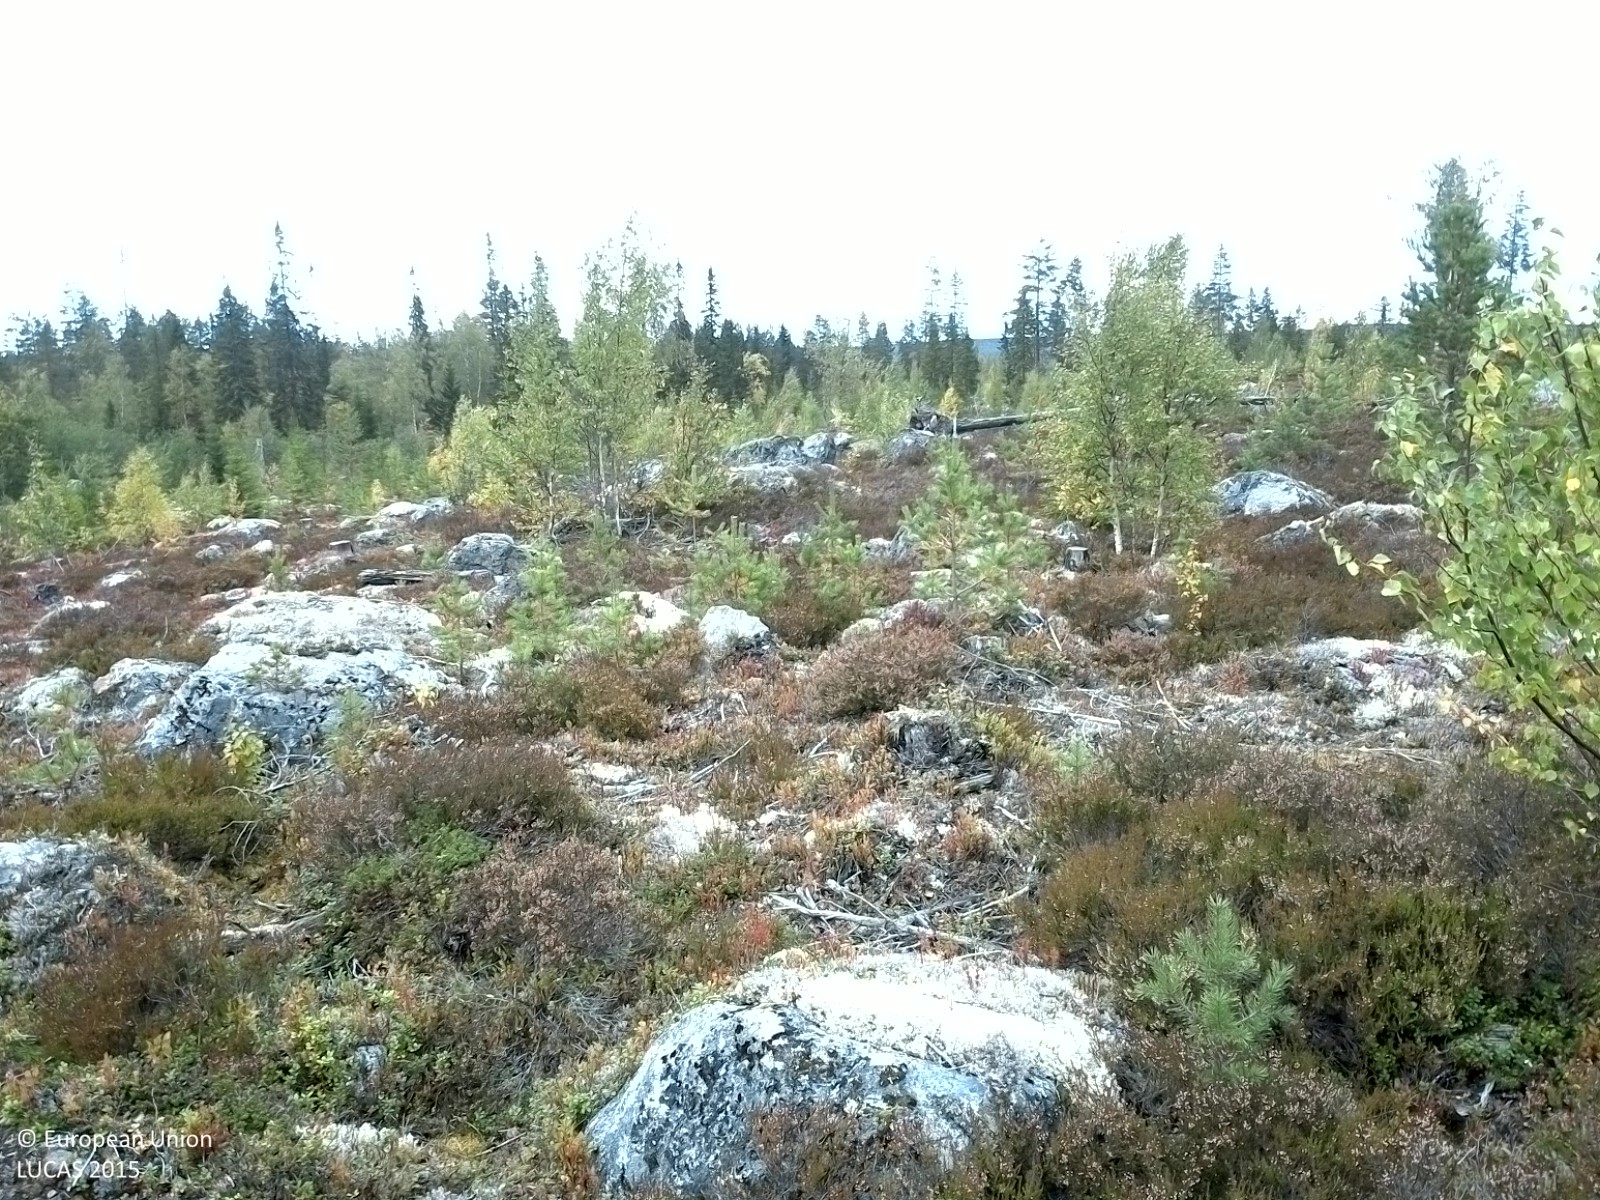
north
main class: Woodland
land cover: Other mixed woodland
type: boreal forest
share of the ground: 10 - 25 %
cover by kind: shrubs 60 %, consolidated bare surface 20 %, lichens and mosses 10 %, coniferous forest trees 5 %, broadleaved forest trees 5 %
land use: Forestry
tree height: < 5 m
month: September
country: SE
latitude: 62.3276
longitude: 15.5971
